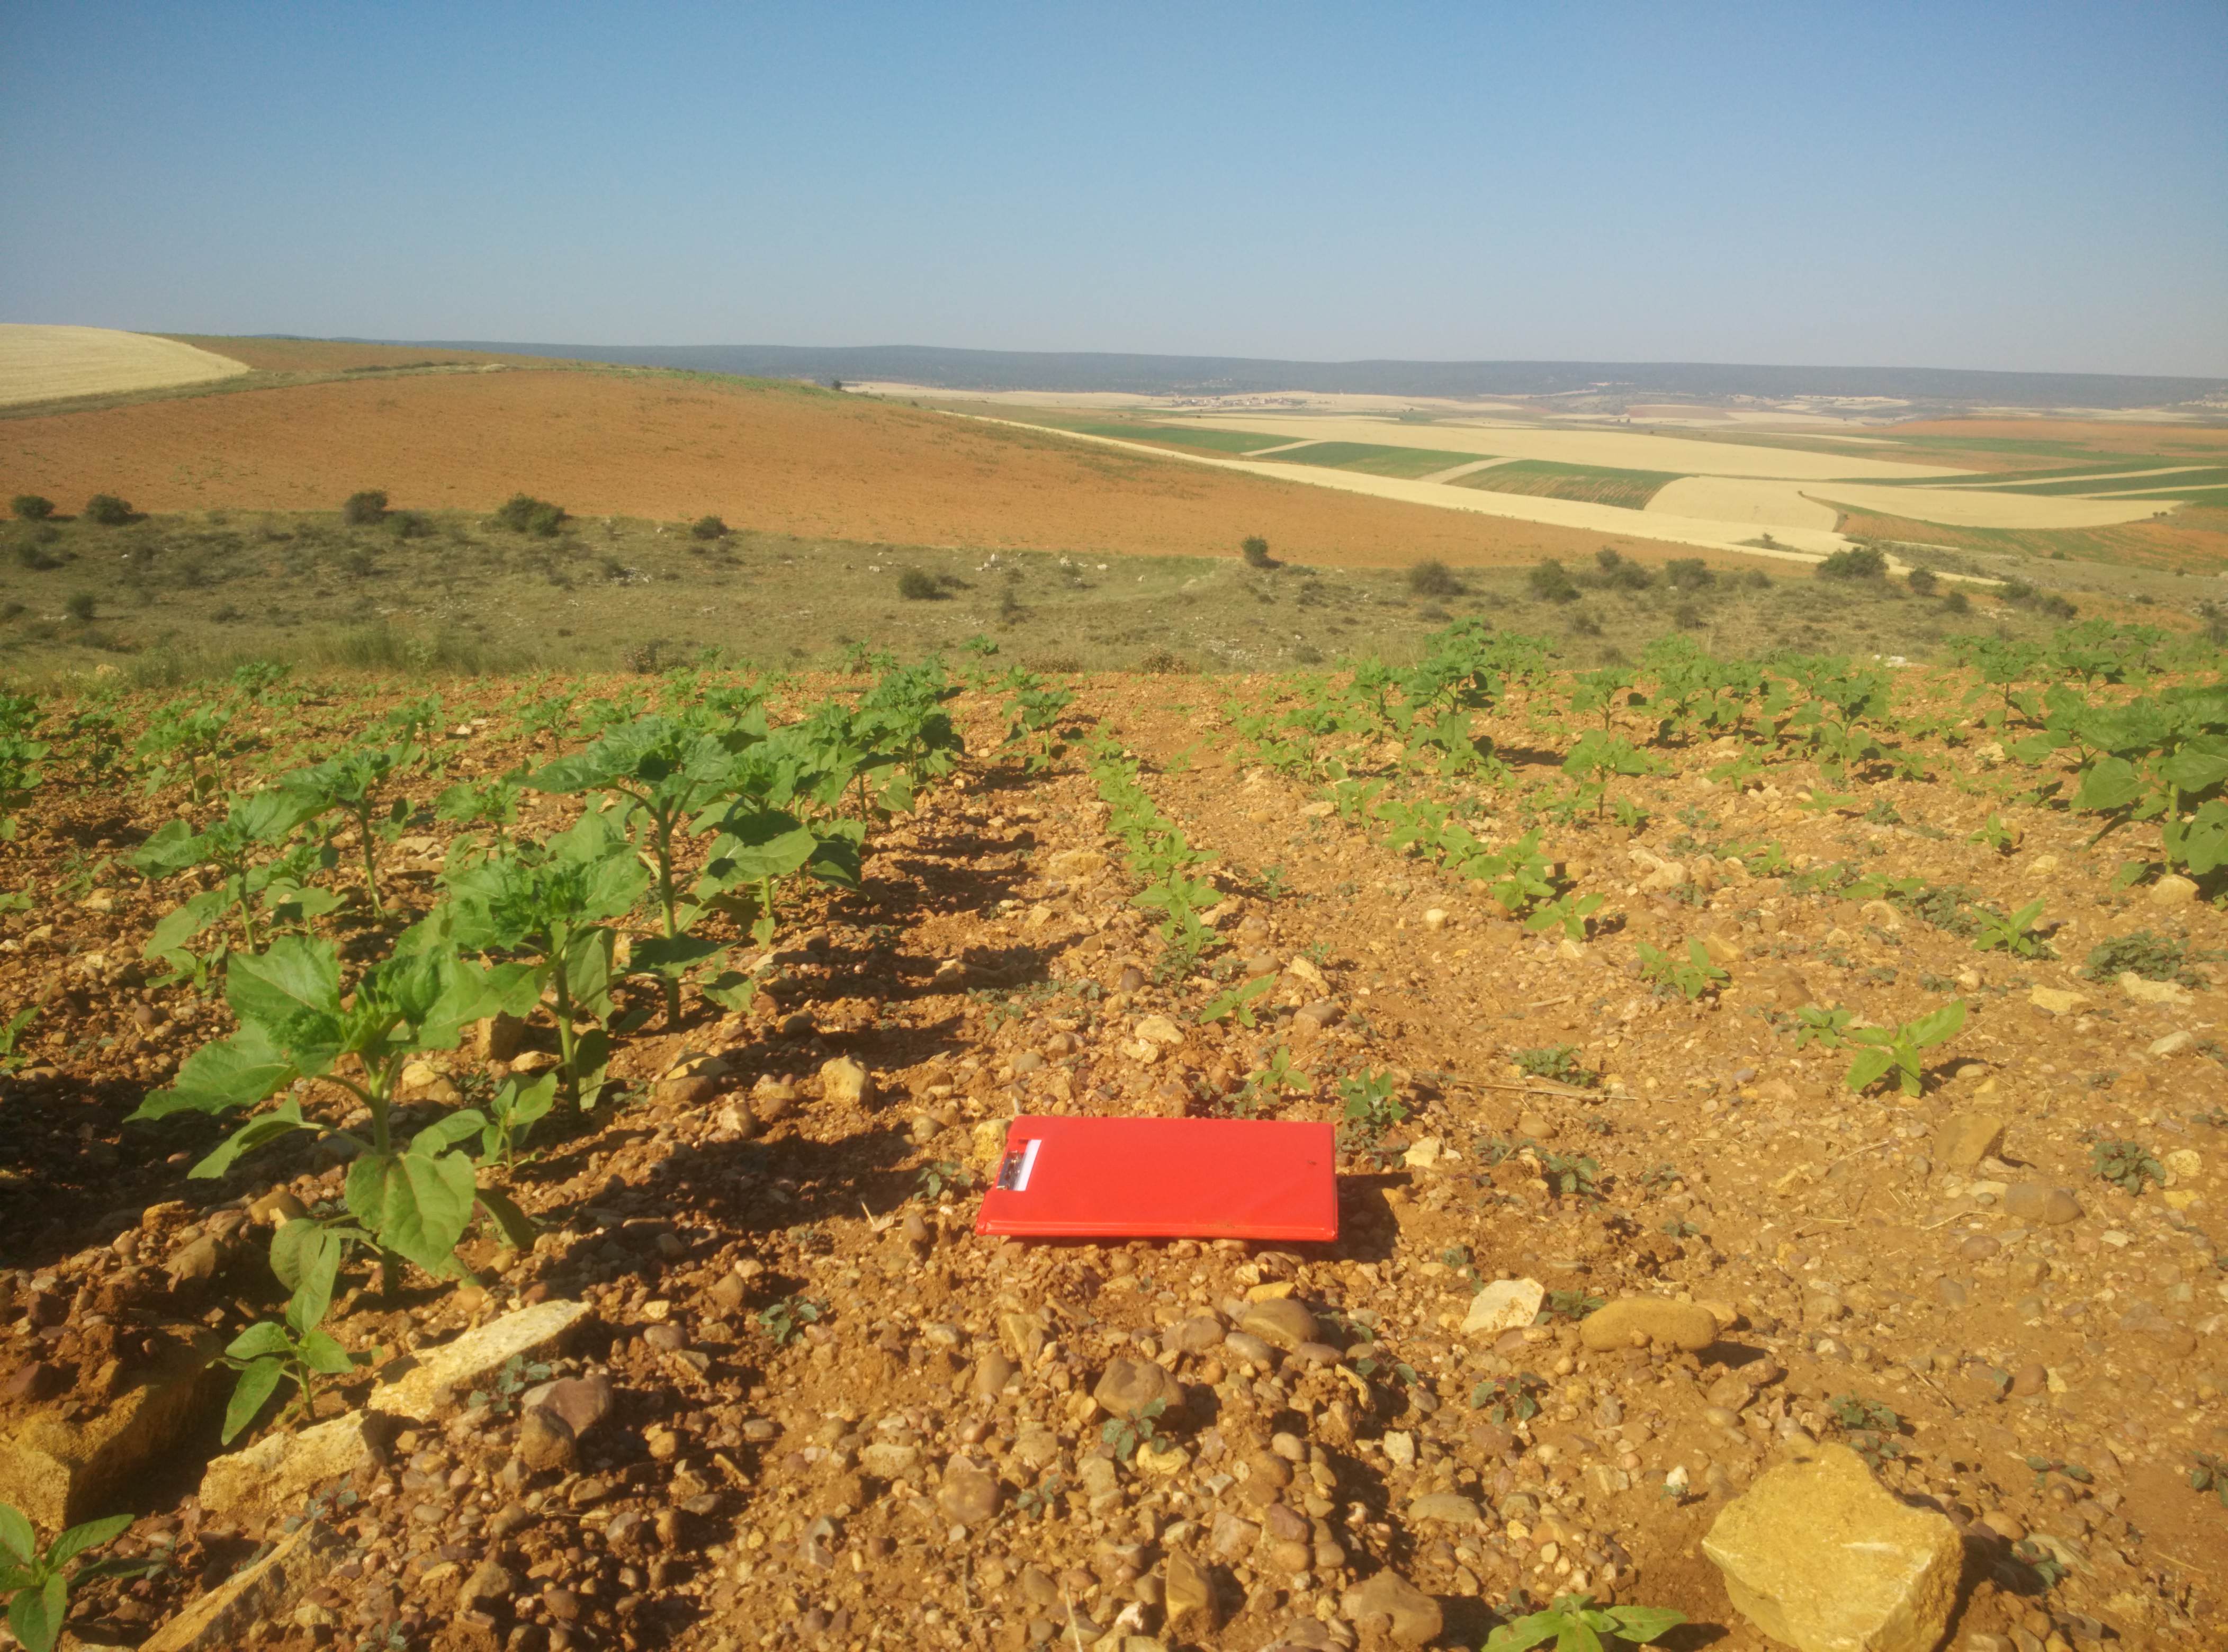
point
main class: Cropland
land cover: Sunflower
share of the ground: 25 - 50 %
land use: Agriculture (excluding fallow land and kitchen gardens)
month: June
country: ES
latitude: 40.7804
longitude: -1.7630
